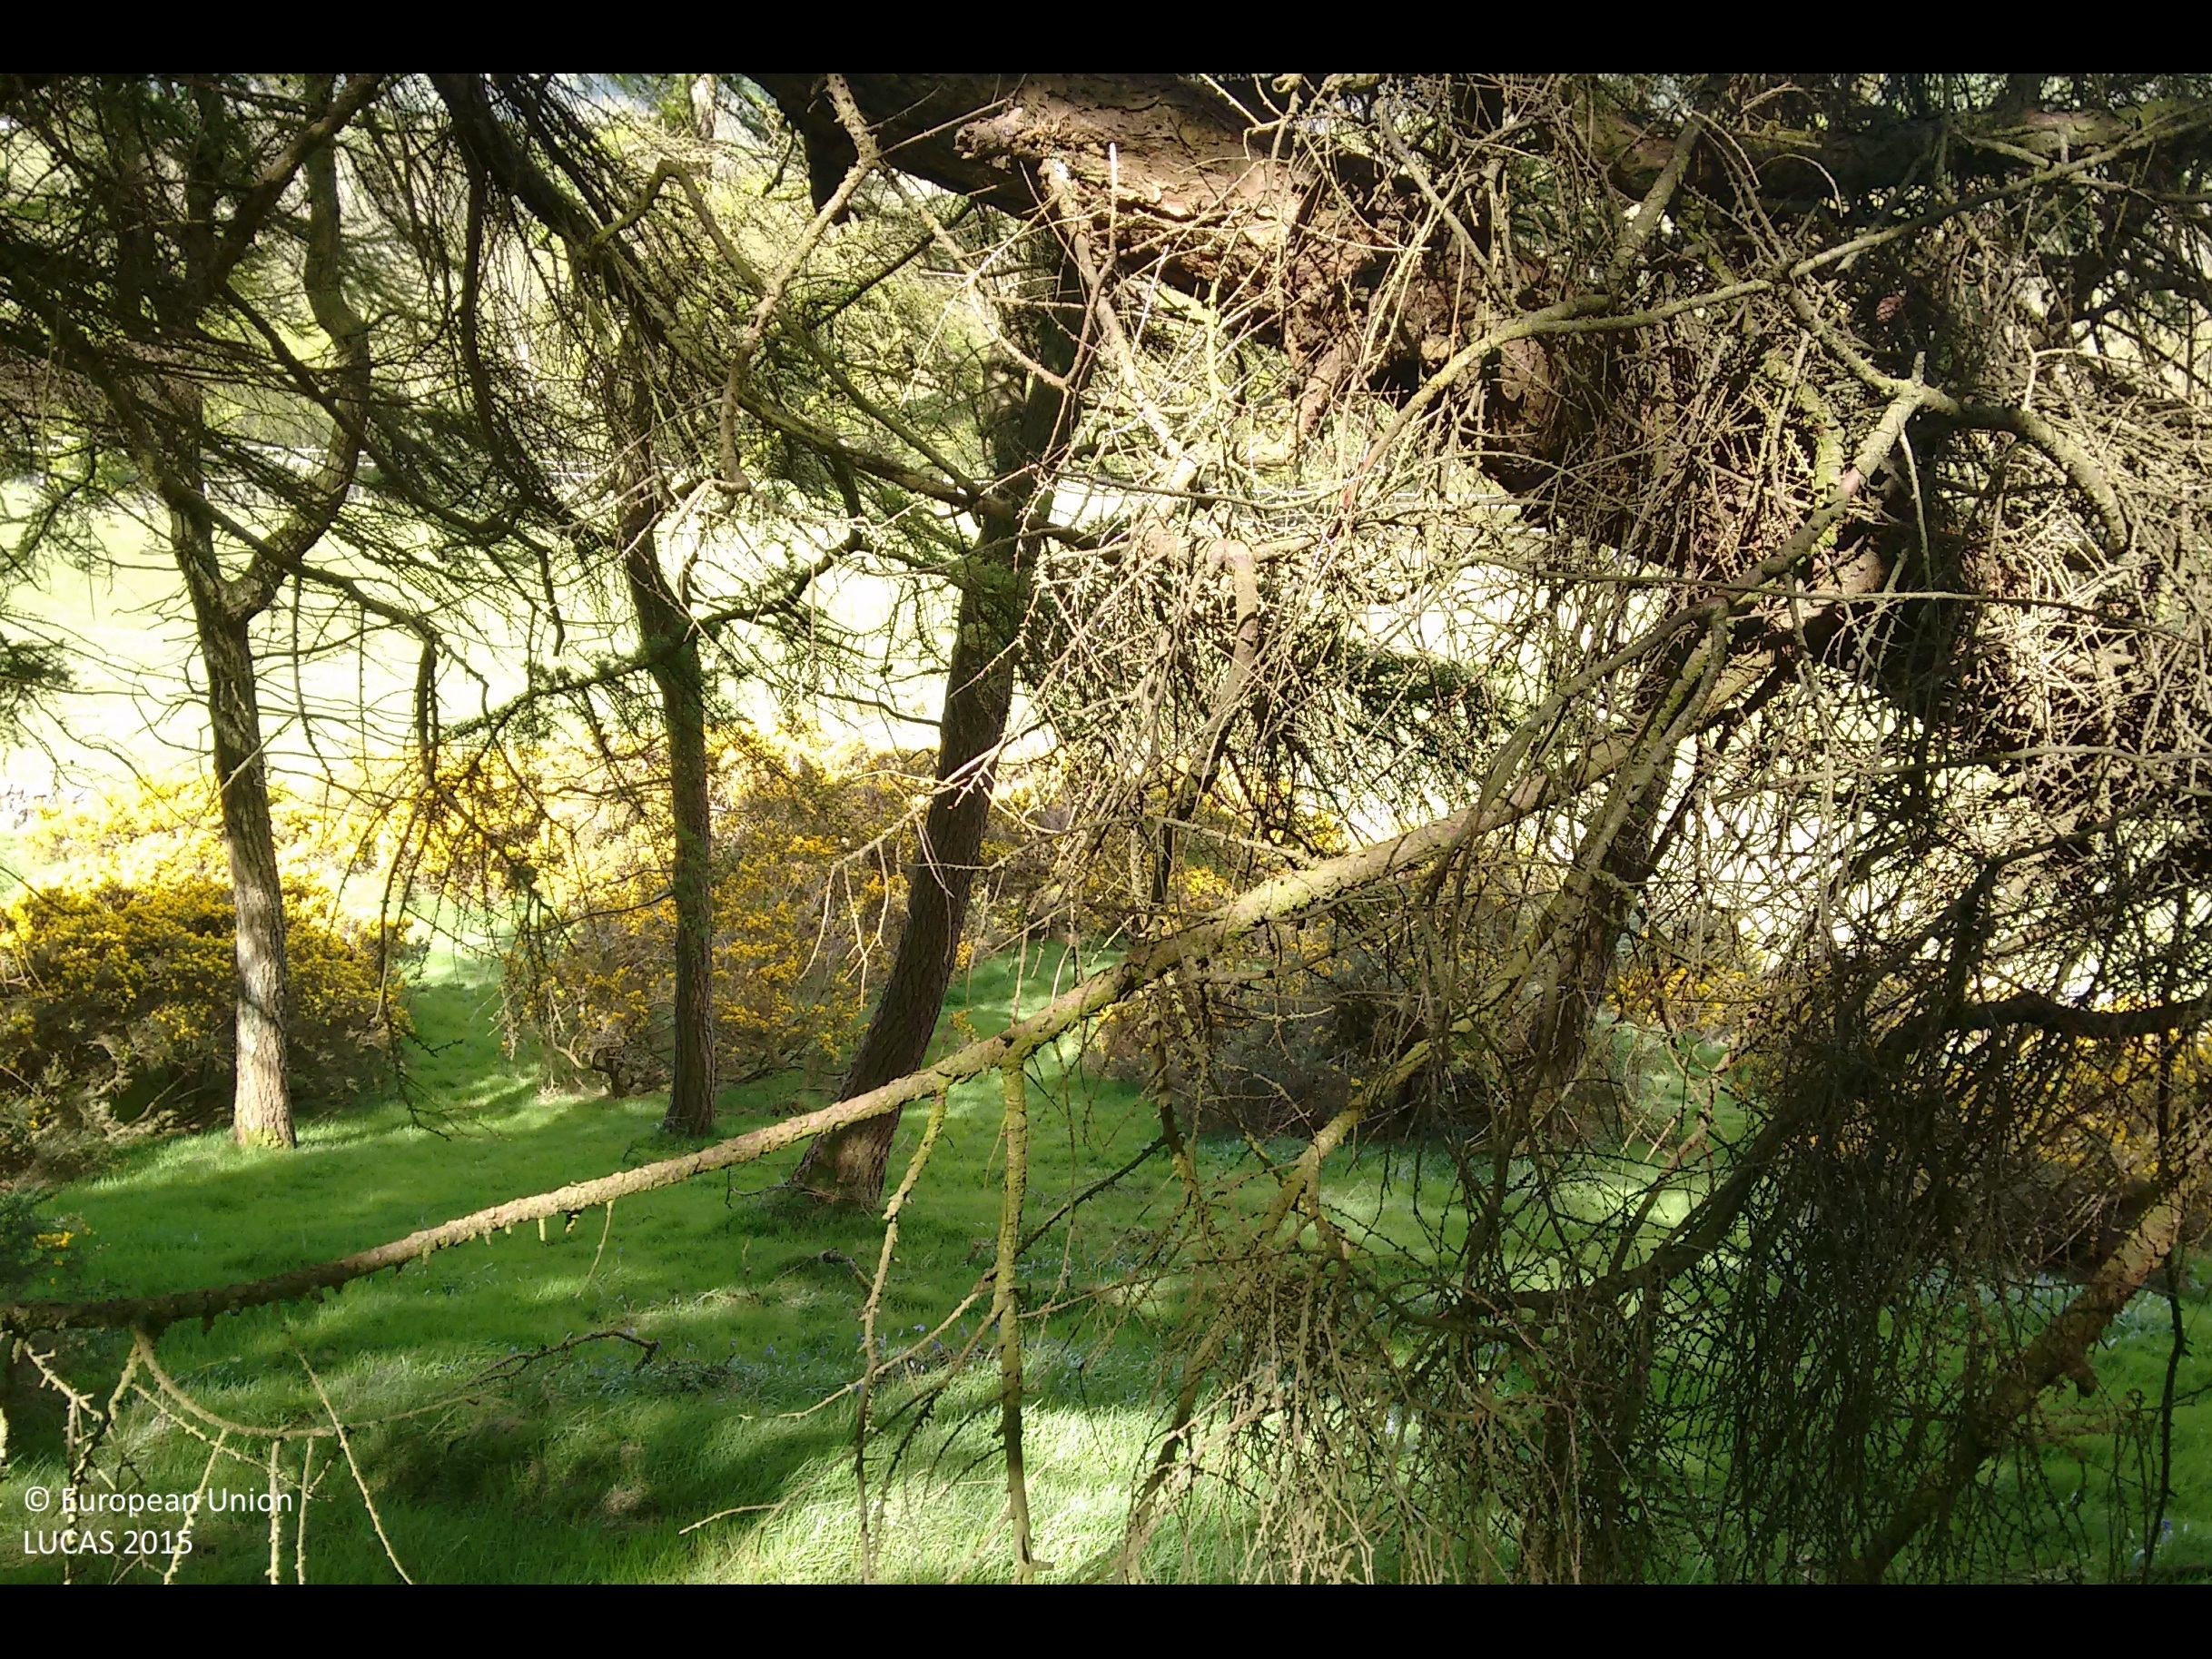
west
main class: Woodland
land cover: Pine dominated coniferous woodland
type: exotic forest
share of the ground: > 75 %
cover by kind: coniferous forest trees 100 %
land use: Semi-natural and natural areas not in use
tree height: > 5 m
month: May
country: GB
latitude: 54.0799
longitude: -2.6777
